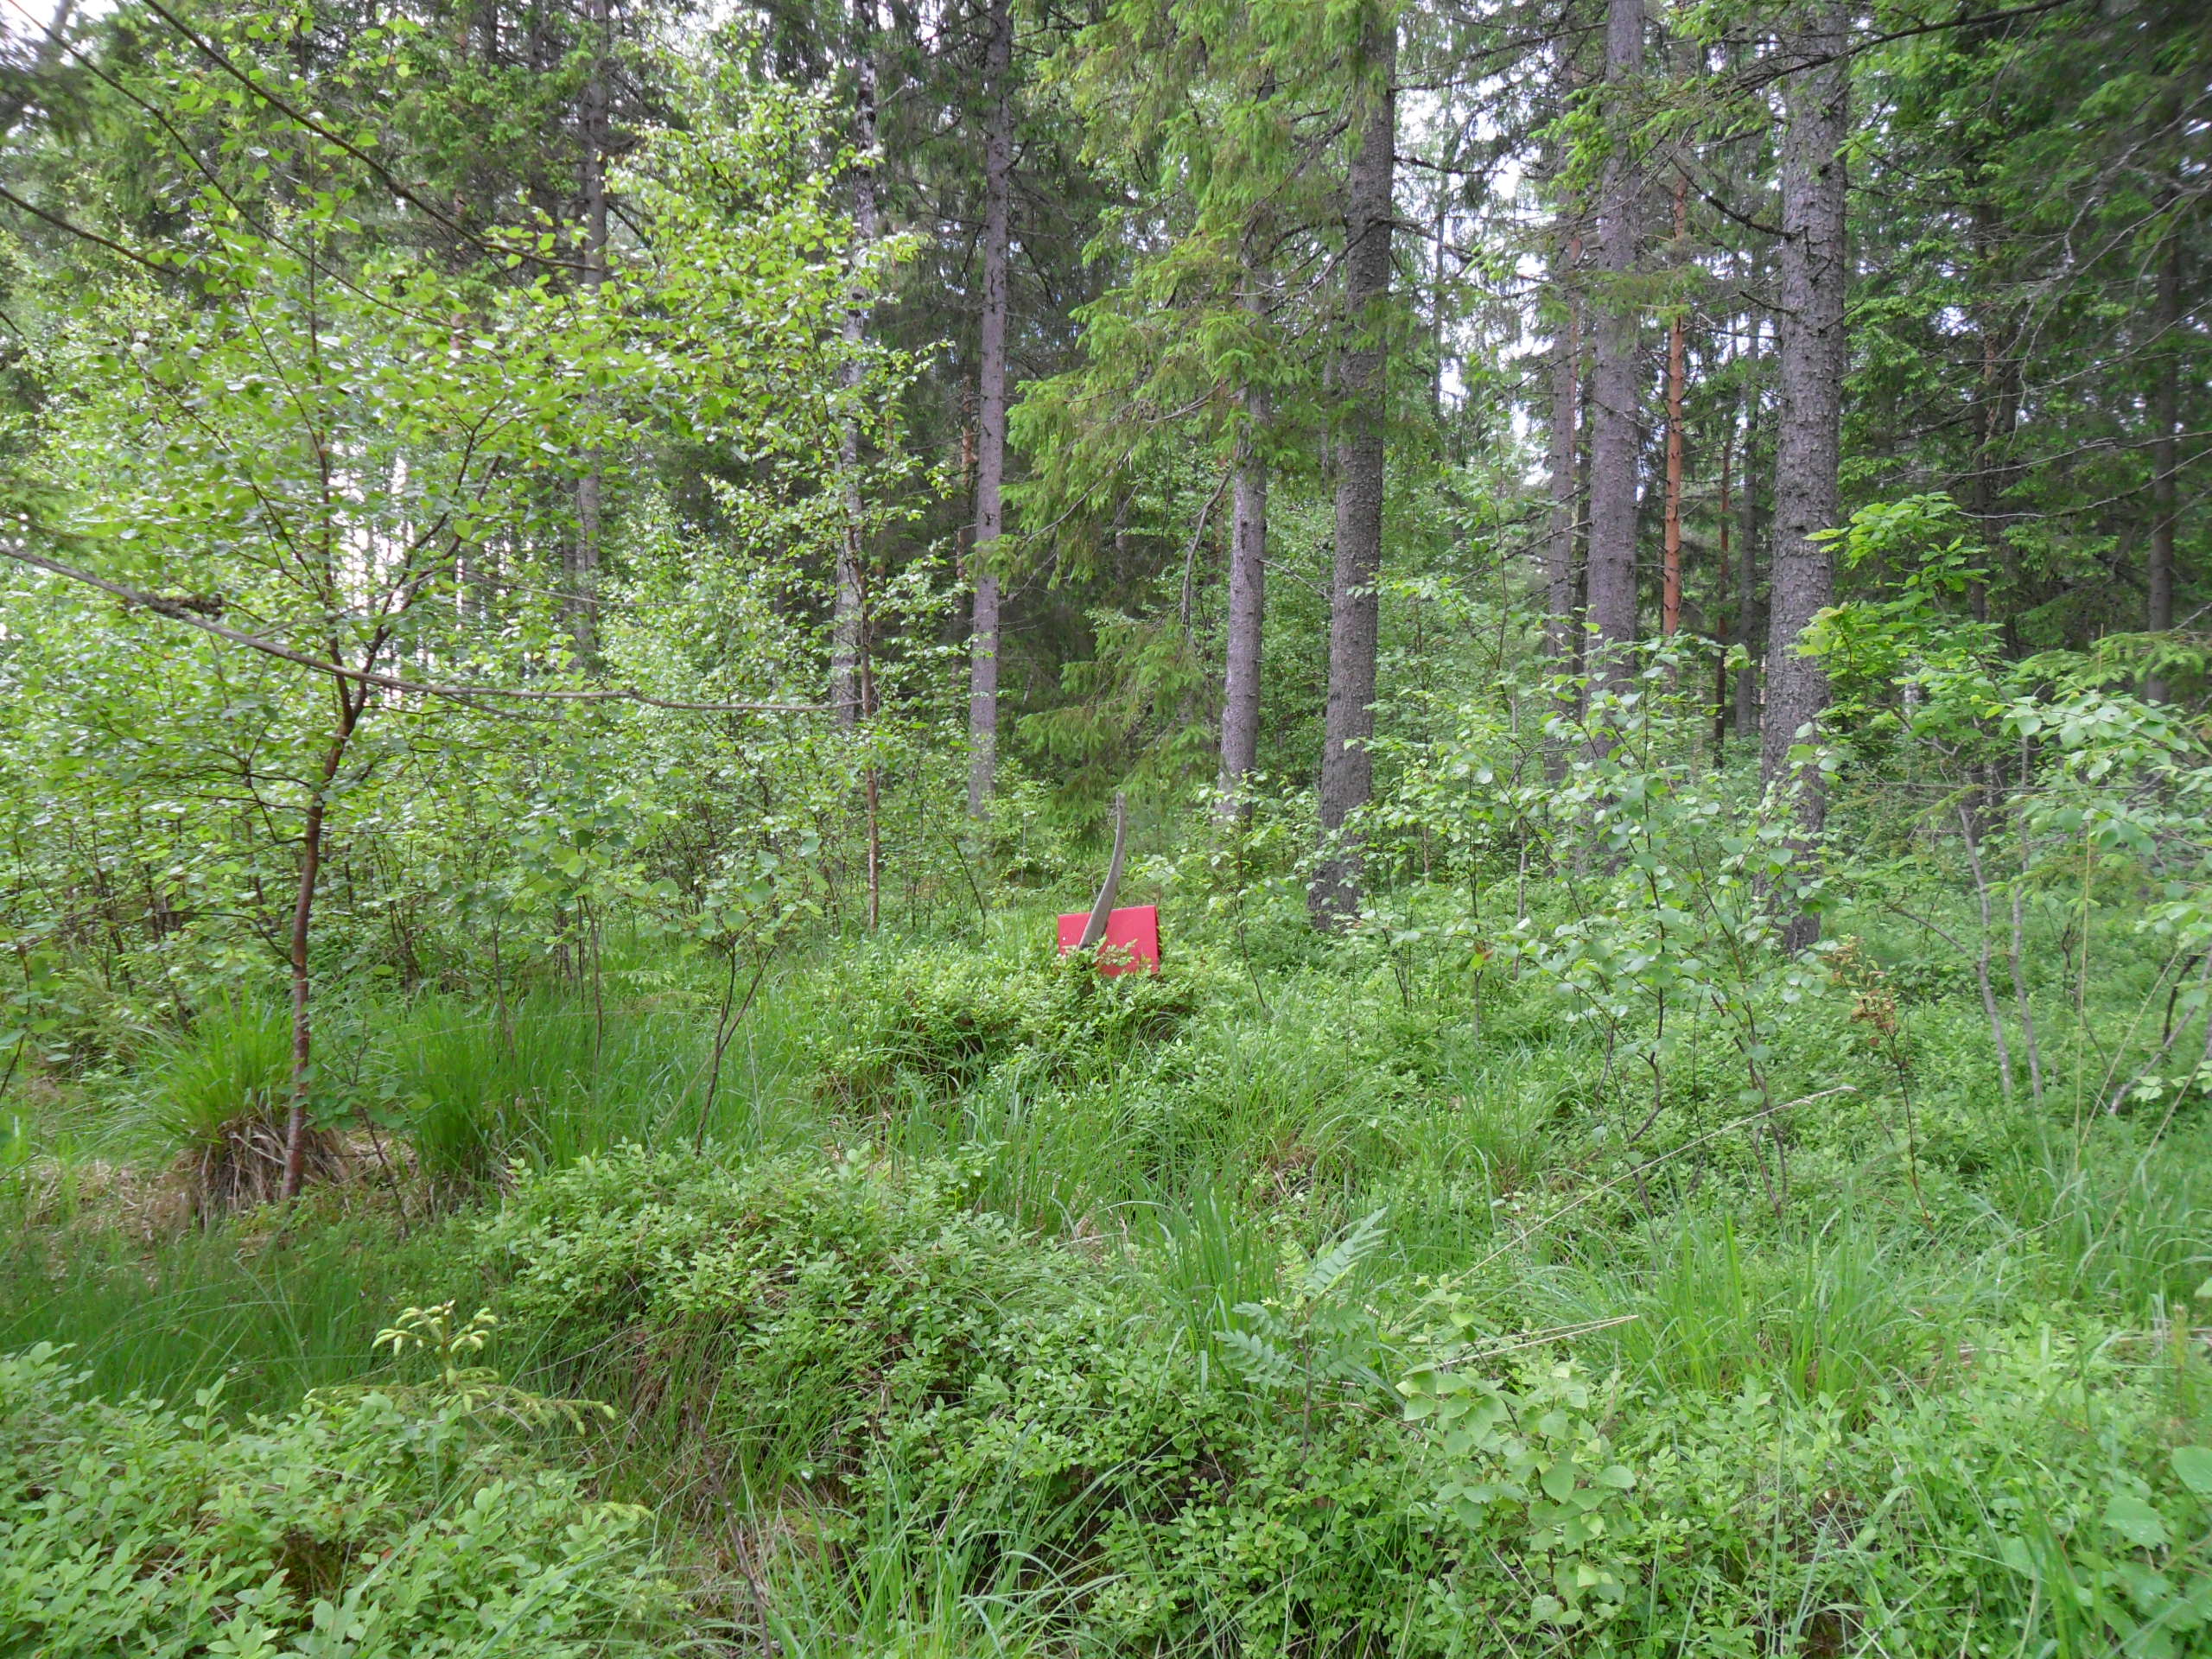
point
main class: Woodland
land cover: Spruce dominated coniferous woodland
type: hemiboreal forest and nemoral coniferous forest and mixed broadleaved-coniferous forest
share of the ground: > 75 %
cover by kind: coniferous forest trees 60 %, broadleaved forest trees 15 %, shrubs 15 %, herbaceous plants 10 %
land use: Forestry
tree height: > 5 m
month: June
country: LV
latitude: 57.4162
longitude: 22.2868
